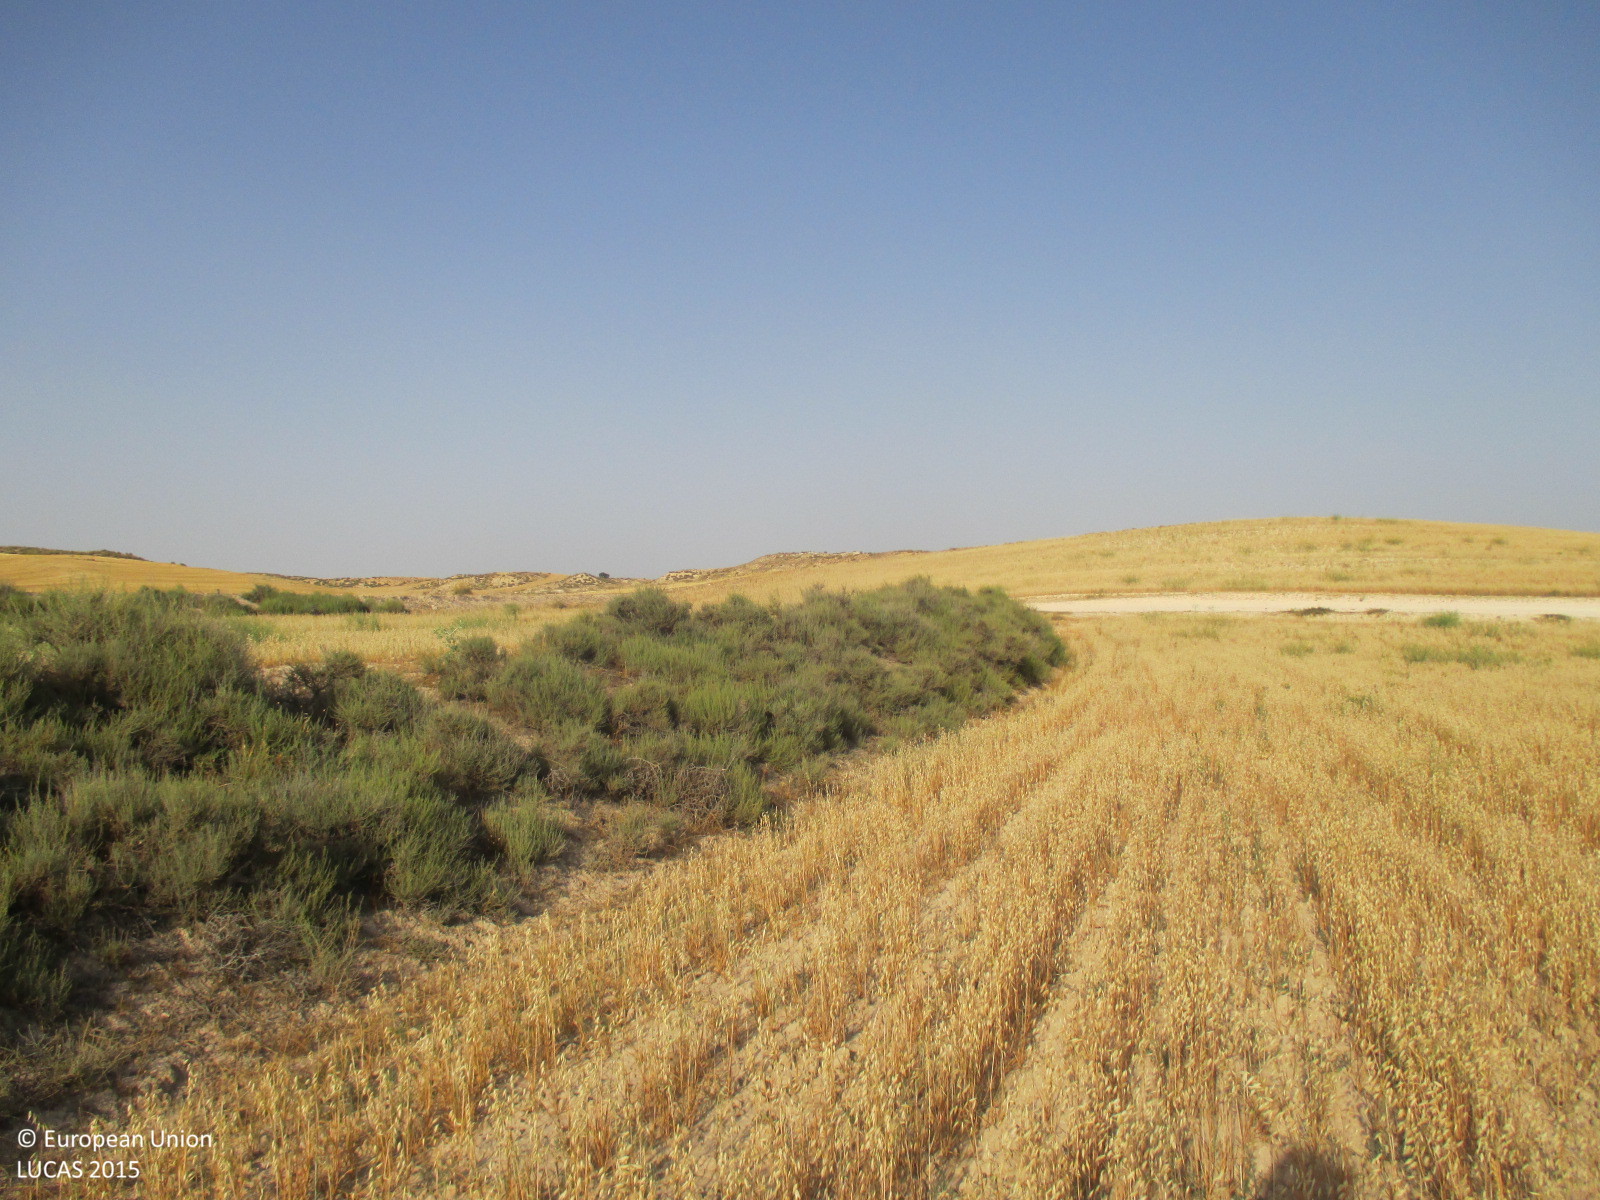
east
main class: Cropland
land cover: Oats
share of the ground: 25 - 50 %
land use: Agriculture (excluding fallow land and kitchen gardens)
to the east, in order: Shruby margins; Oats; Grass margins; Tracks; Grass margins; Oats; Grass margins; Barley
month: June
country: ES
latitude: 37.7669
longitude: -2.4647
